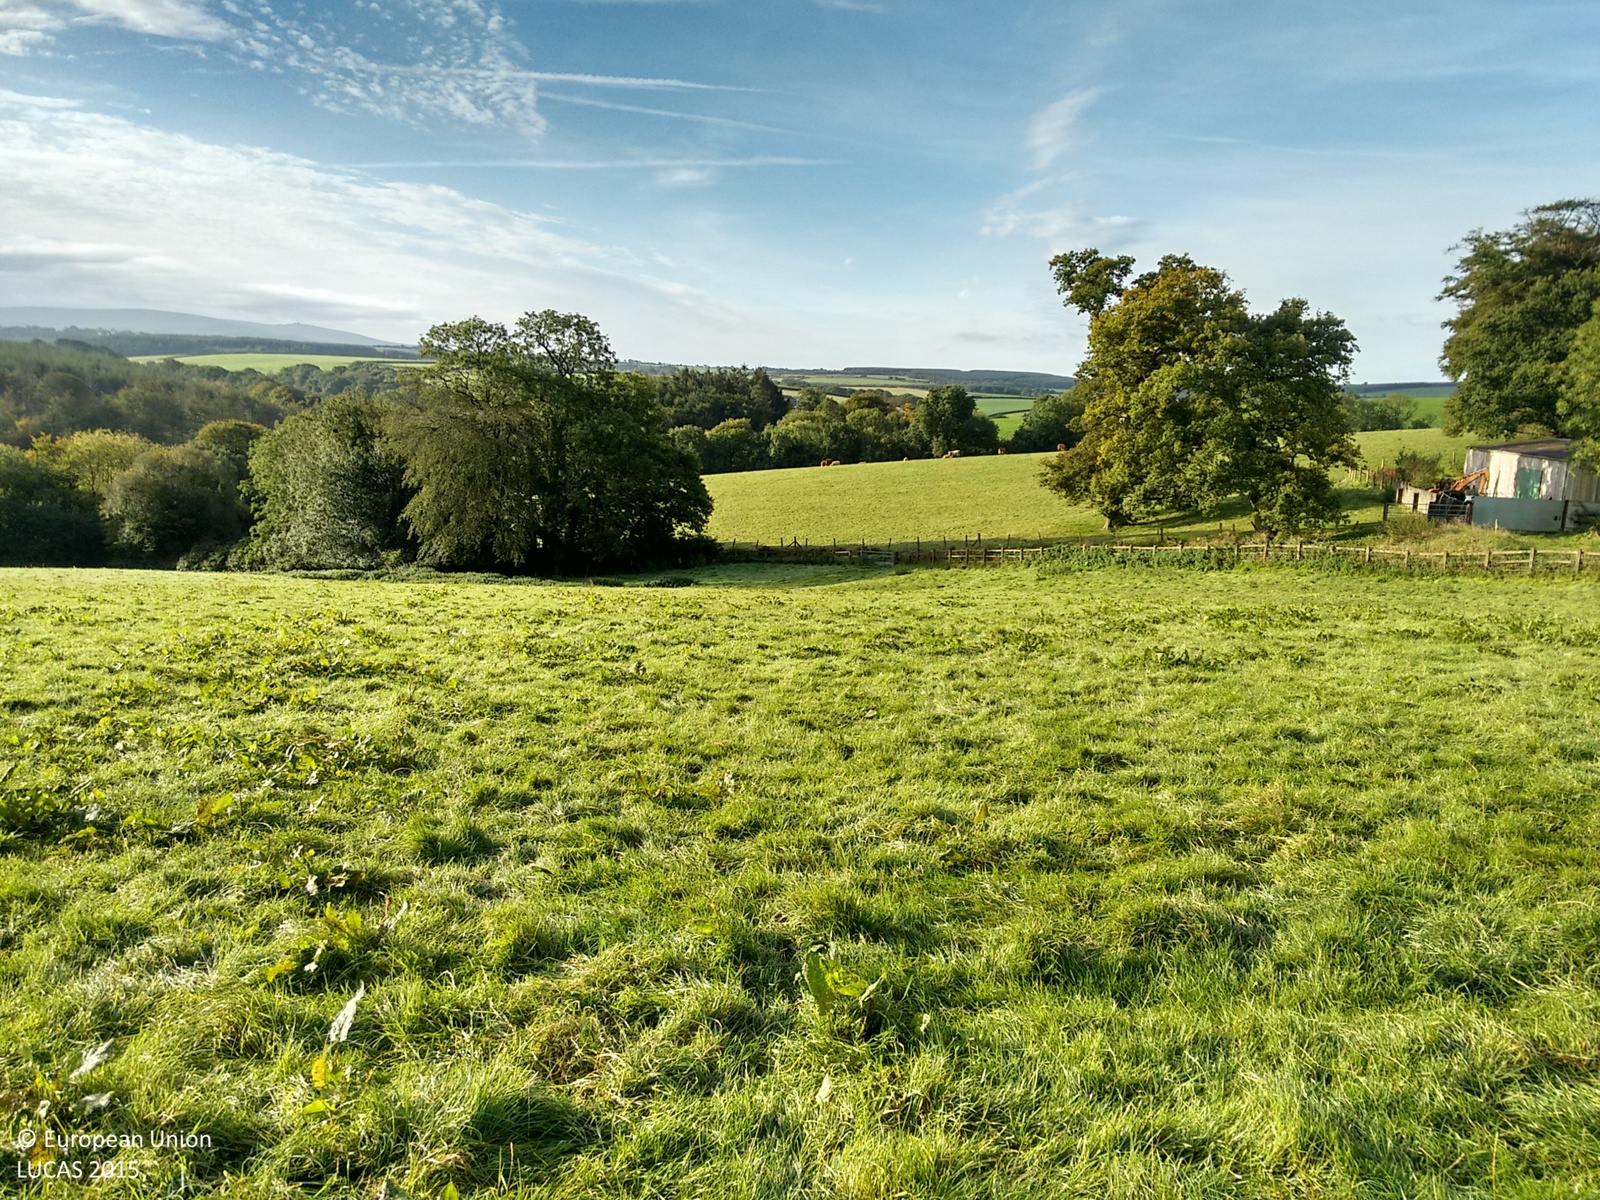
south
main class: Grassland
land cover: Grassland without tree/shrub cover
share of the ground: > 75 %
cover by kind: herbaceous plants 100 %
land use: Agriculture (excluding fallow land and kitchen gardens)
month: September
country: GB
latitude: 50.7610
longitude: -4.1173
